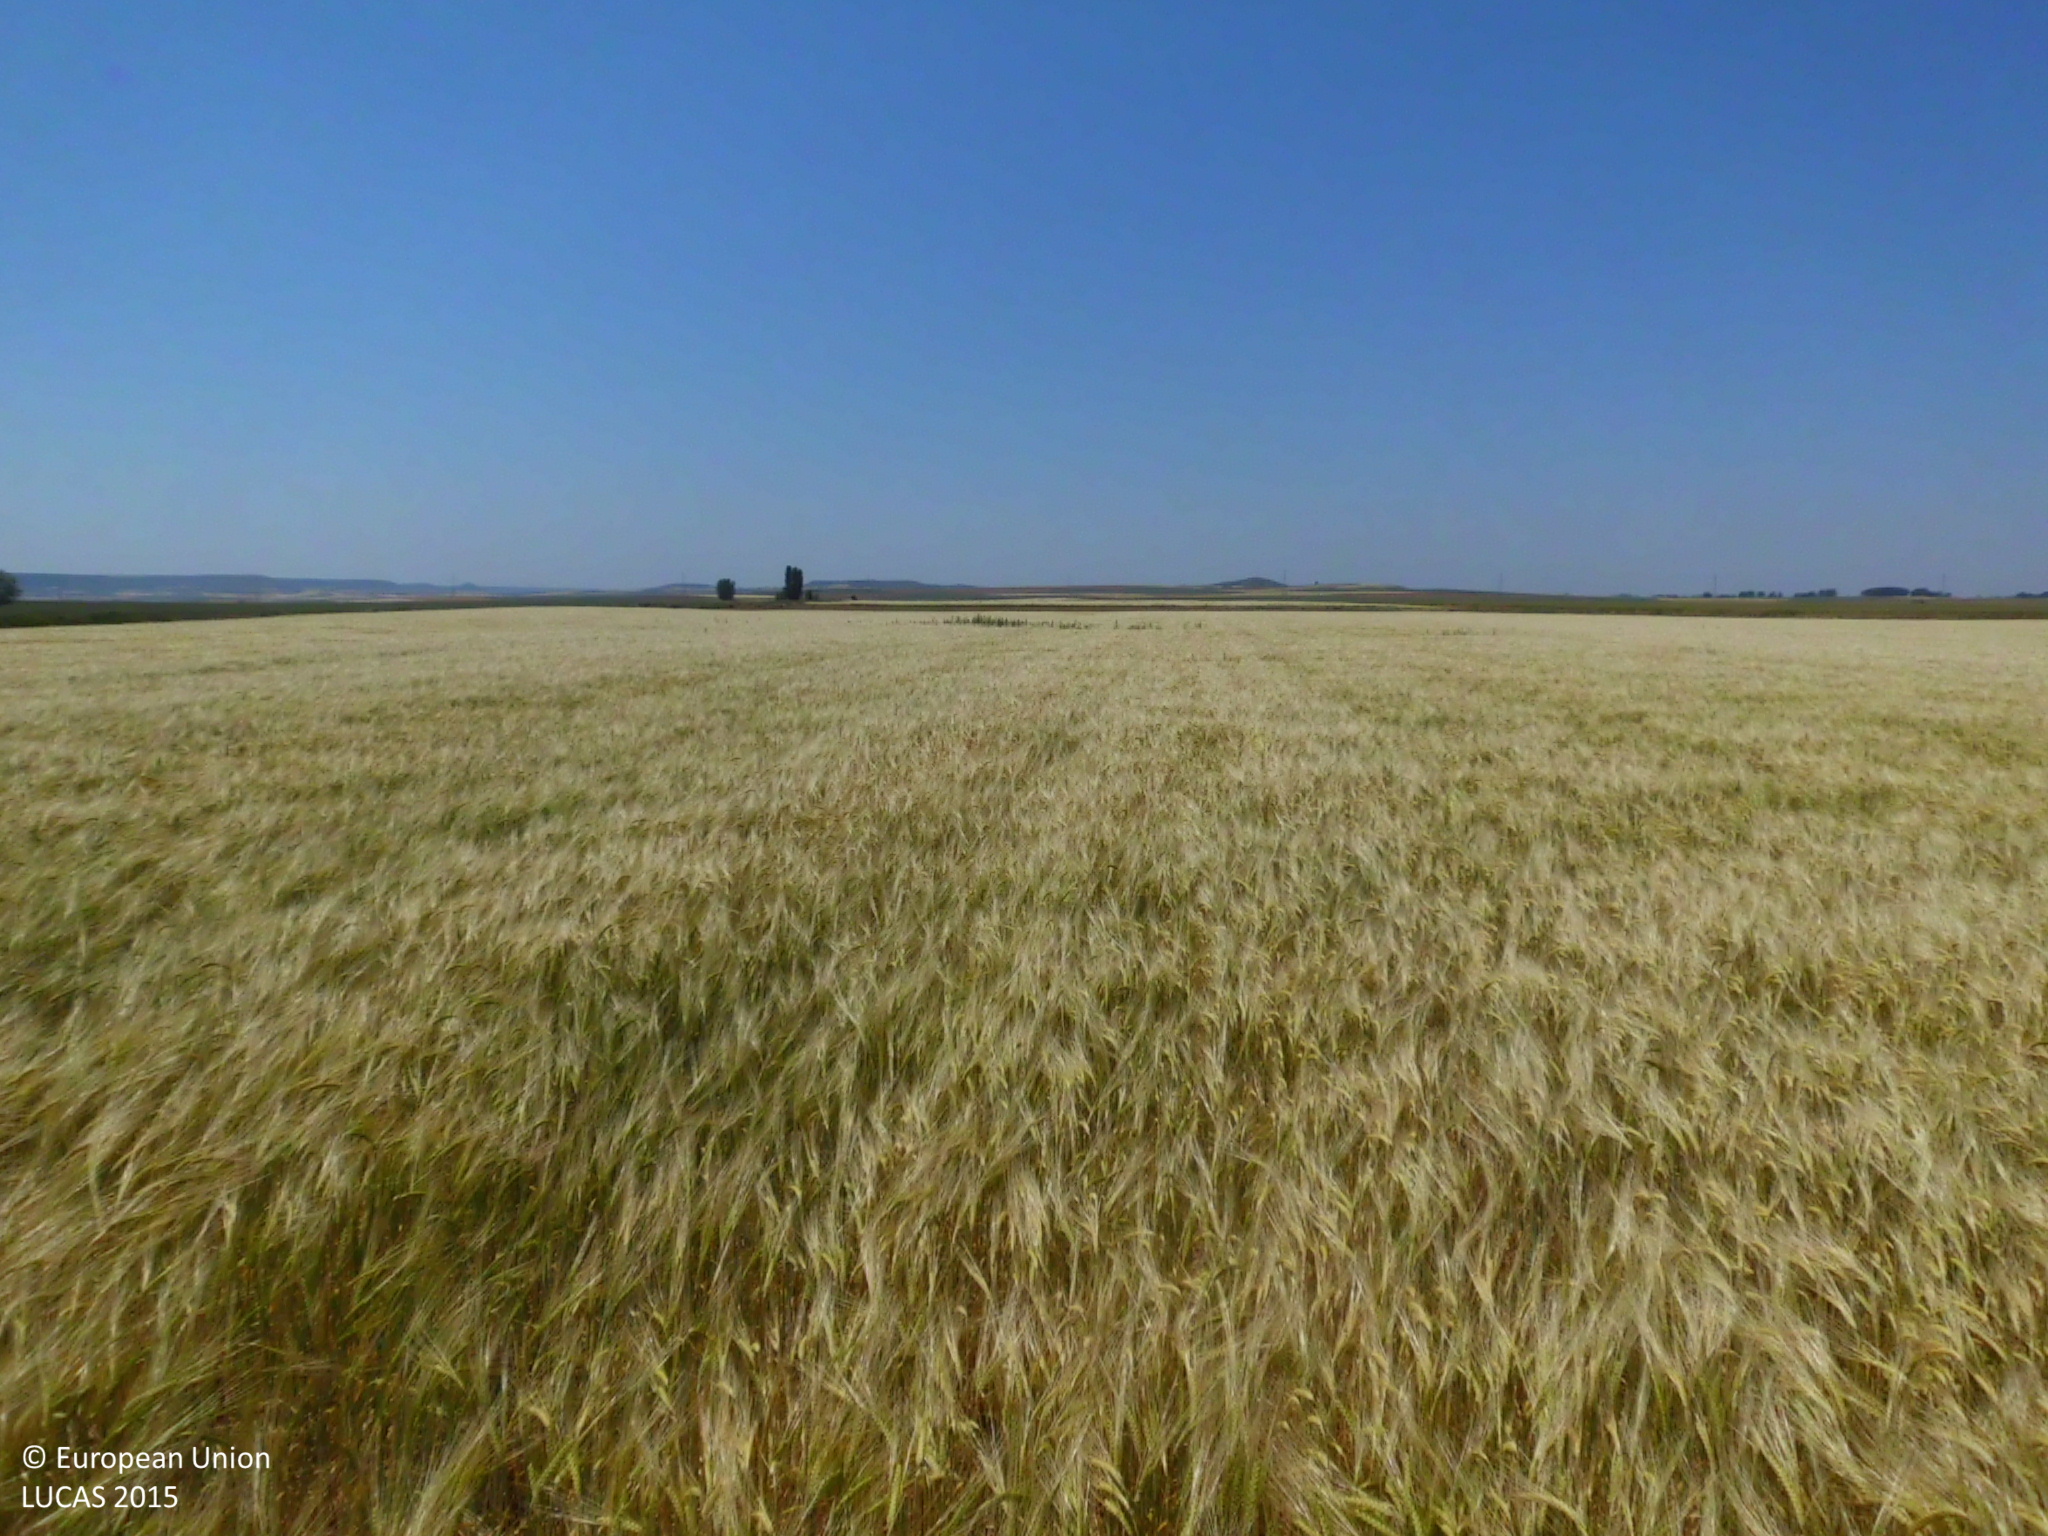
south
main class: Cropland
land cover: Barley
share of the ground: > 75 %
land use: Agriculture (excluding fallow land and kitchen gardens)
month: June
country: ES
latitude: 42.3809
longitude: -4.1940
